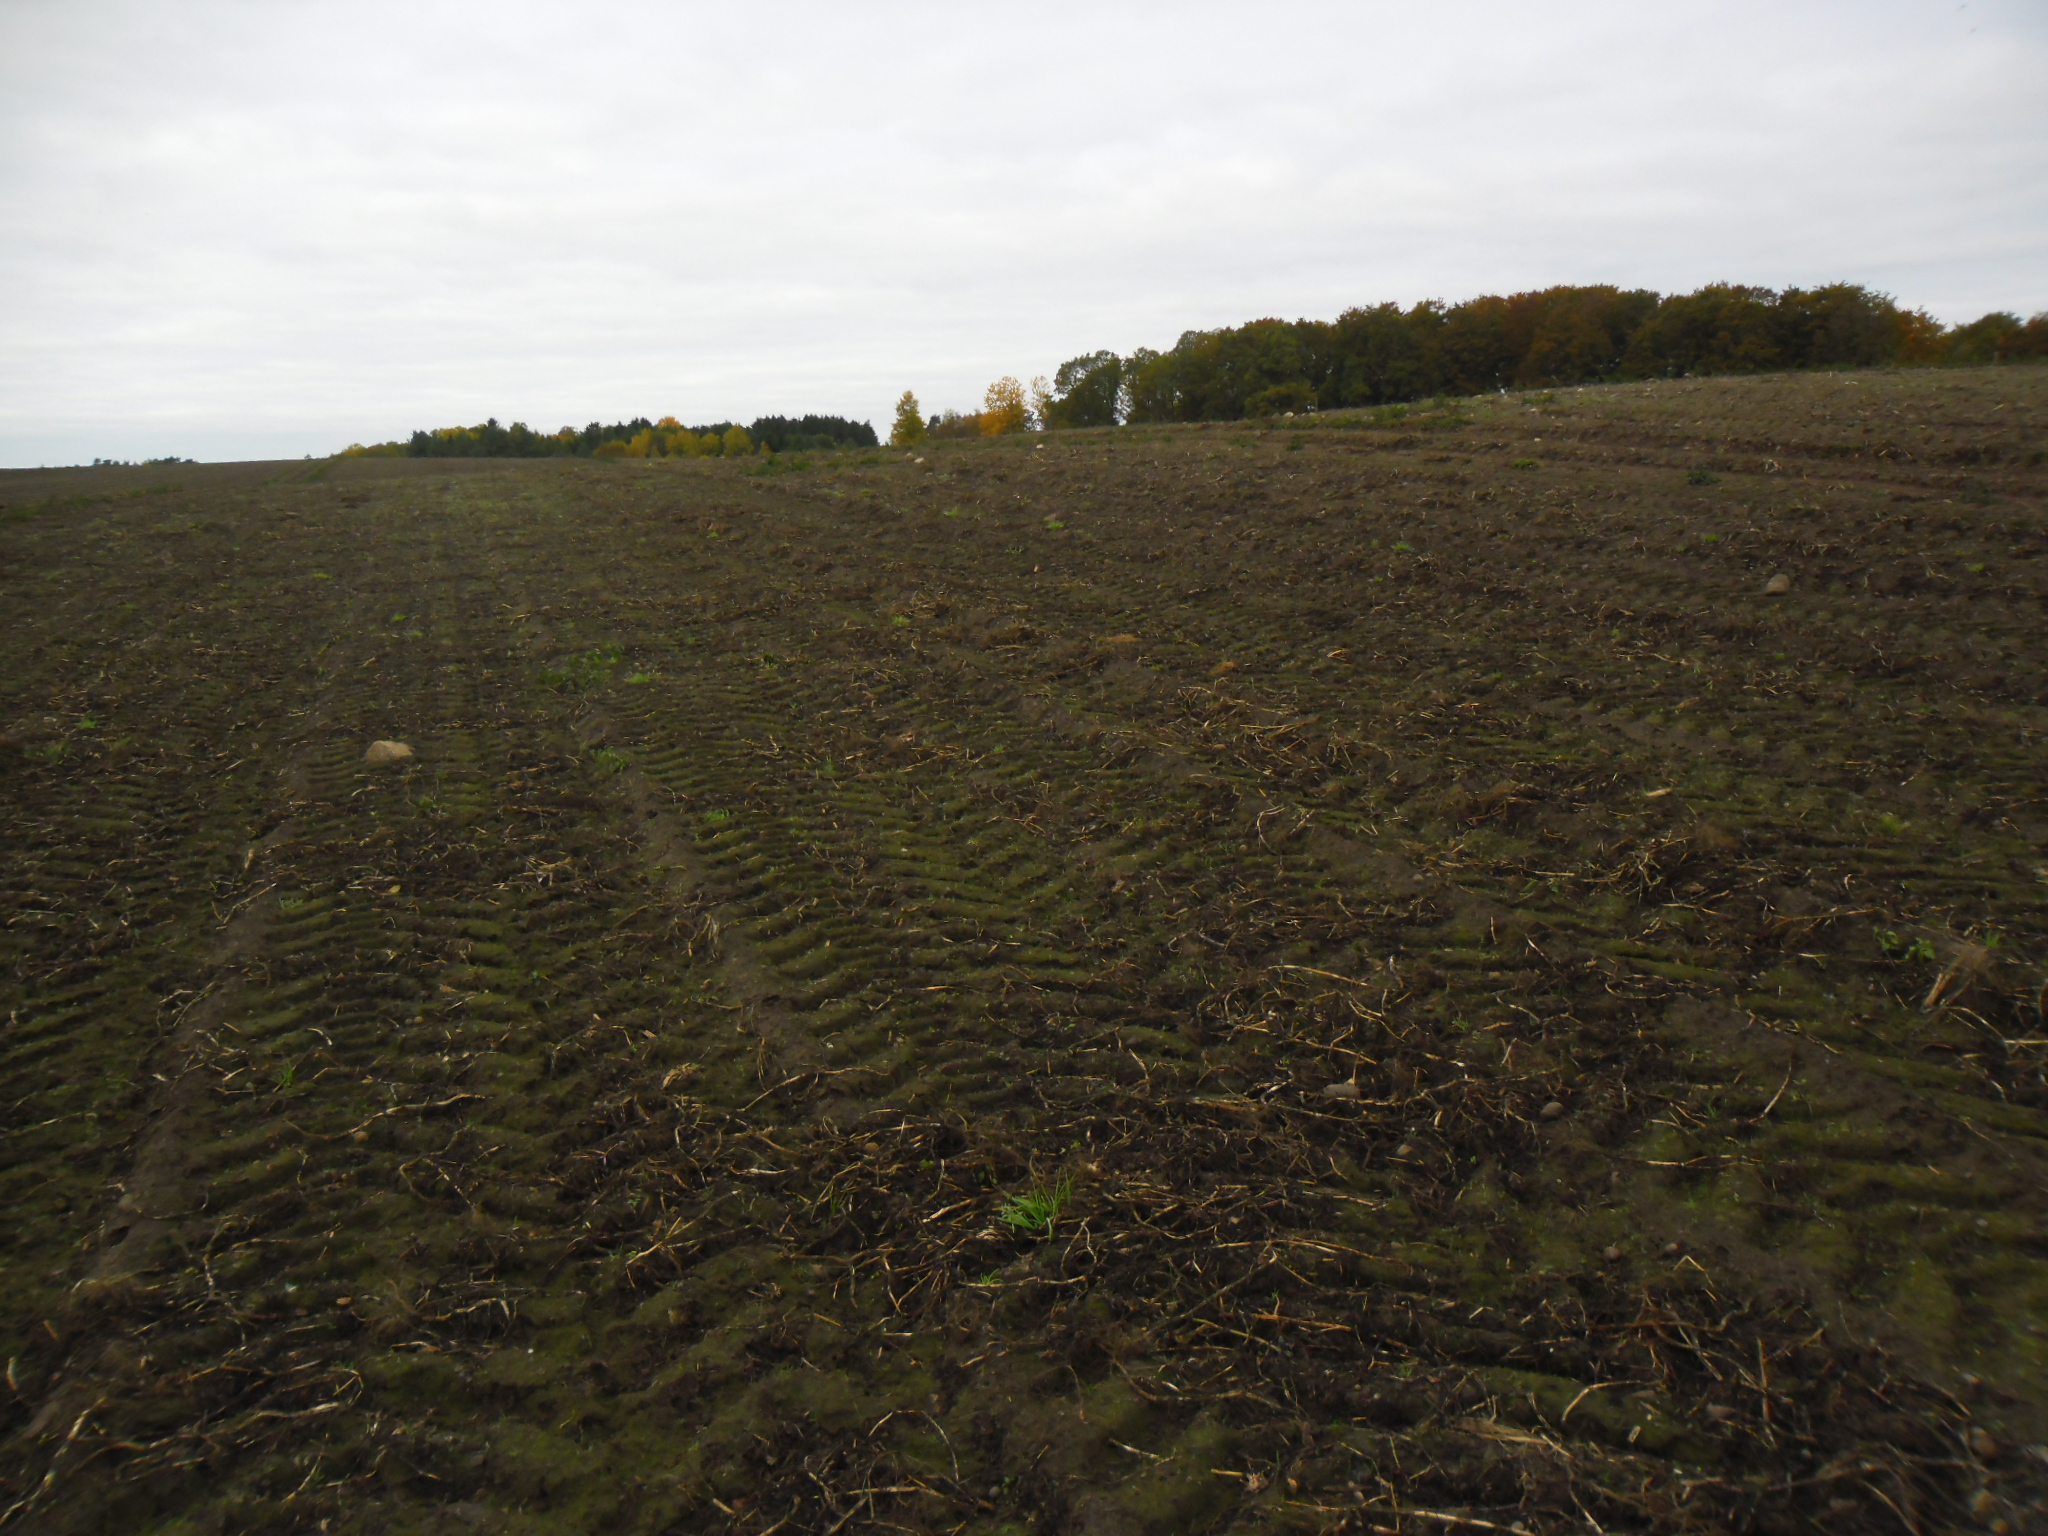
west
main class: Cropland
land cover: Potatoes
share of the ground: < 10 %
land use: Agriculture (excluding fallow land and kitchen gardens)
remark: Harvested field
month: October
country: SE
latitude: 56.1870
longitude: 13.7517
